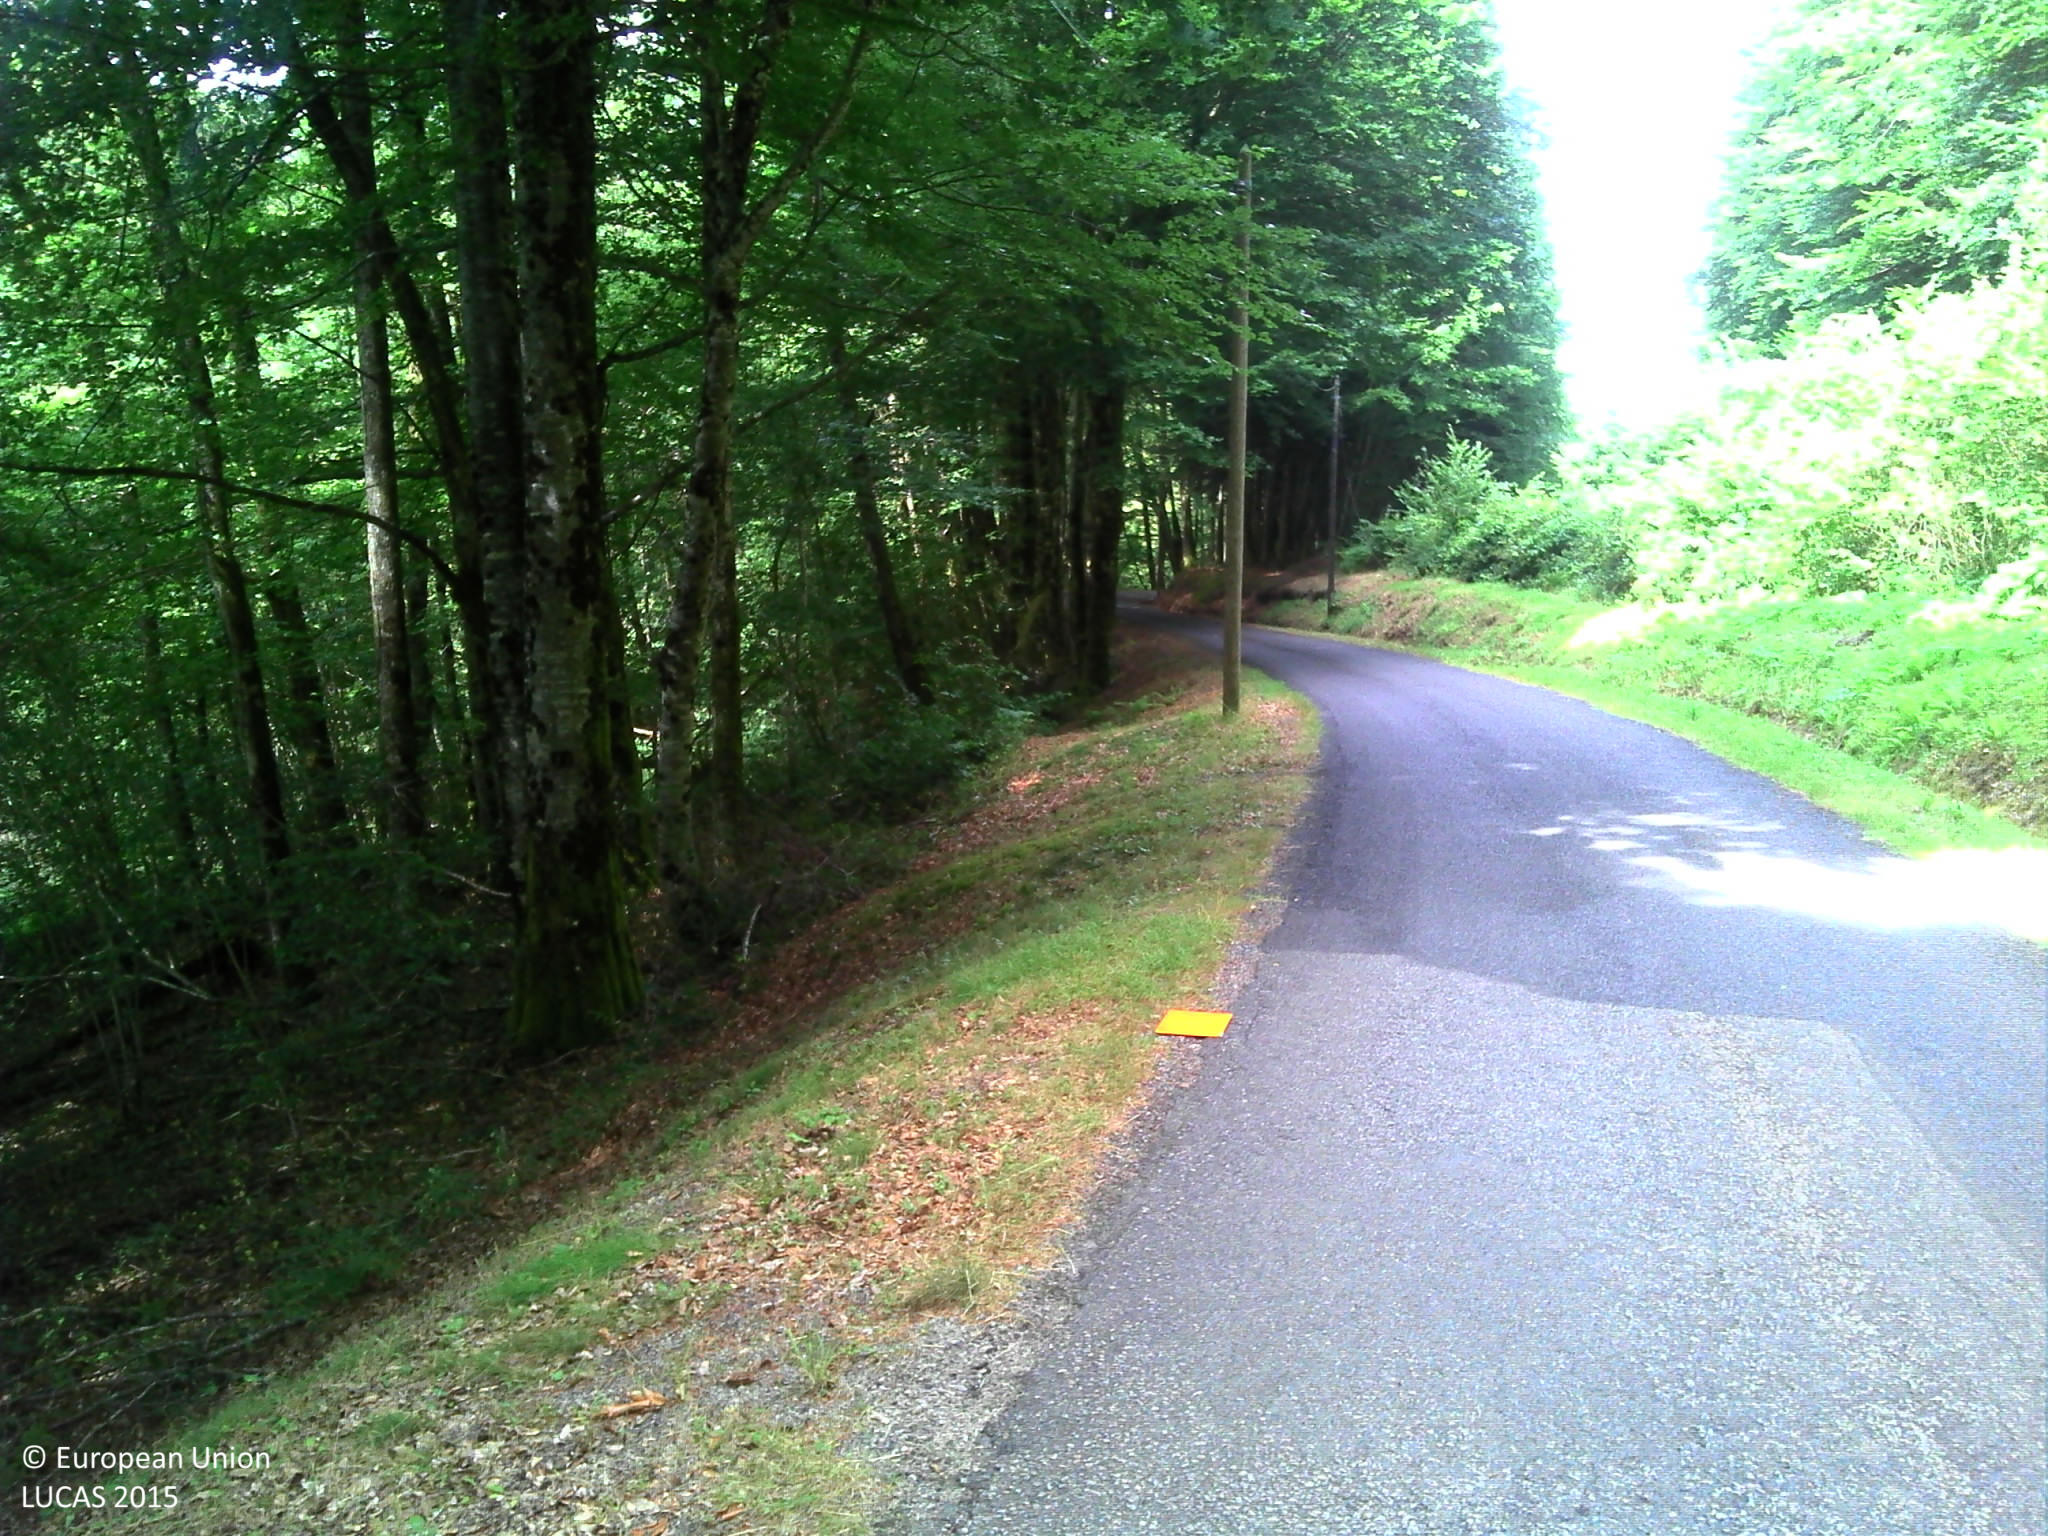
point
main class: Woodland
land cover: Broadleaved woodland
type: beech forest
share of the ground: > 75 %
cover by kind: broadleaved forest trees 70 %, herbaceous plants 25 %, lichens and mosses 5 %
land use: Forestry
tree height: > 5 m
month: July
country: FR
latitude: 45.6593
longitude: 1.8453
